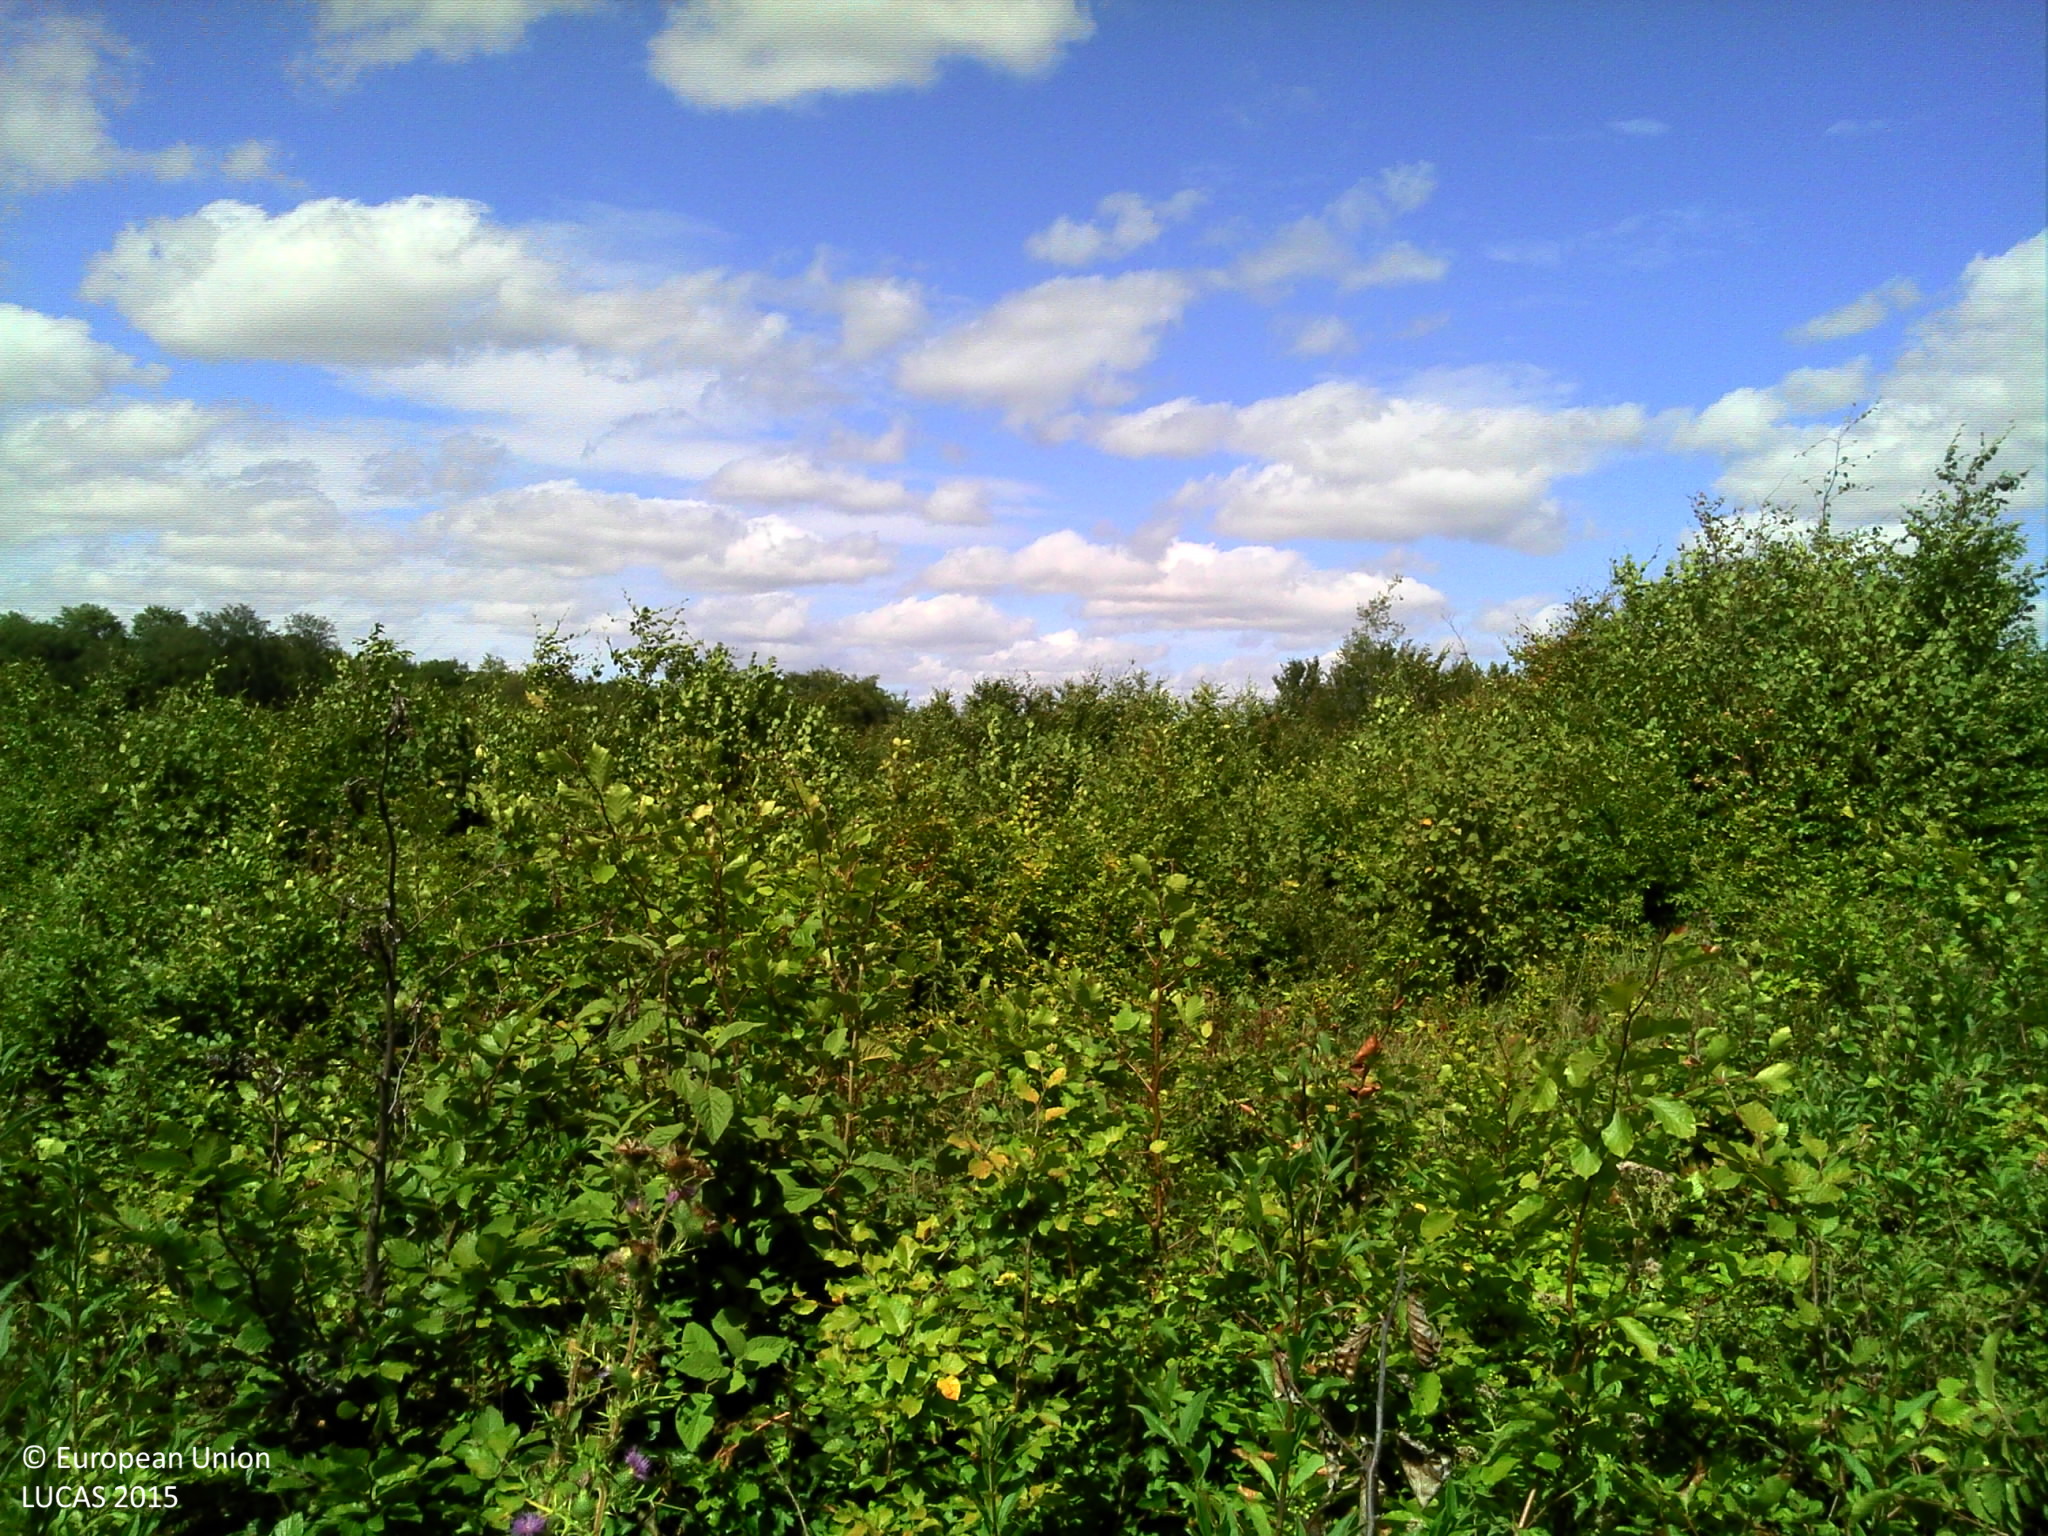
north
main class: Woodland
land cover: Broadleaved woodland
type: mesophytic deciduous forest
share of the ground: > 75 %
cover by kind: broadleaved forest trees 90 %, herbaceous plants 5 %, lichens and mosses 5 %
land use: Forestry
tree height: < 5 m
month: August
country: FR
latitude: 47.8317
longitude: 4.8291
